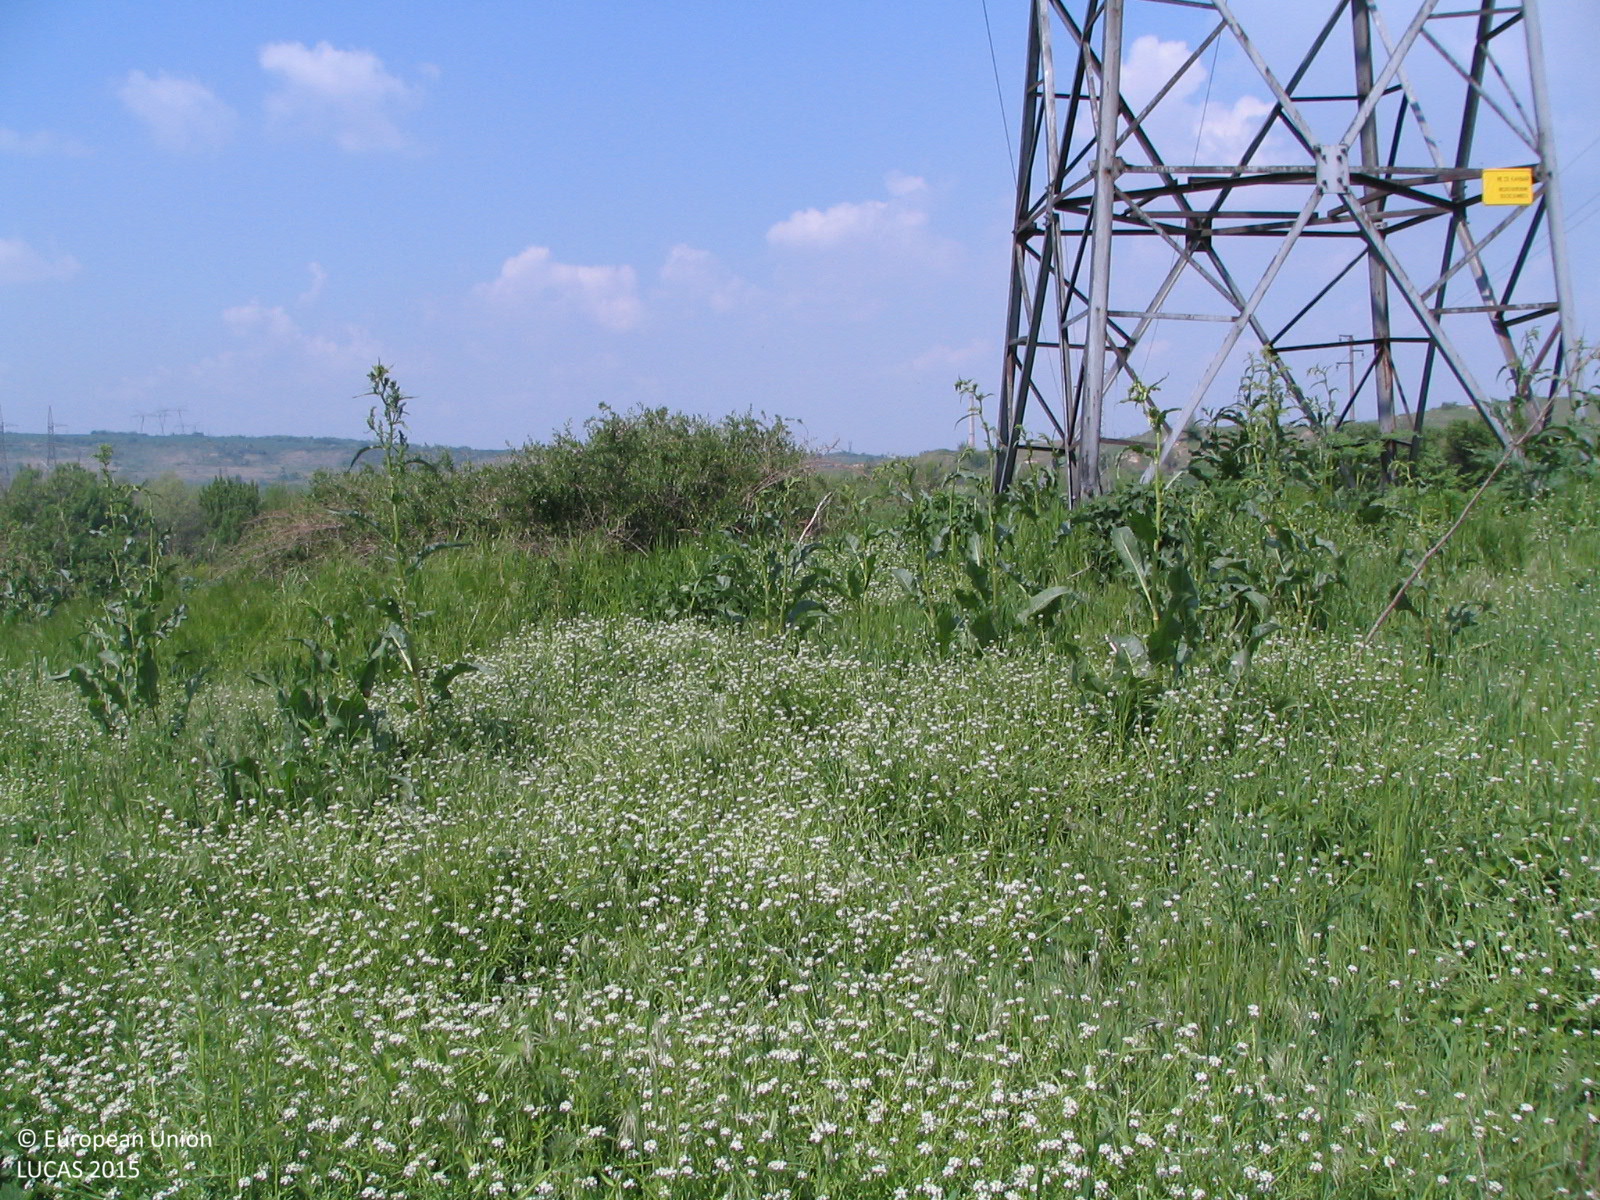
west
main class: Shrubland
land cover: Shrubland without tree cover
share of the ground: > 75 %
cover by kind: shrubs 60 %, herbaceous plants 40 %
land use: Fallow land
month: May
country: BG
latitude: 43.6717
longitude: 23.8562
